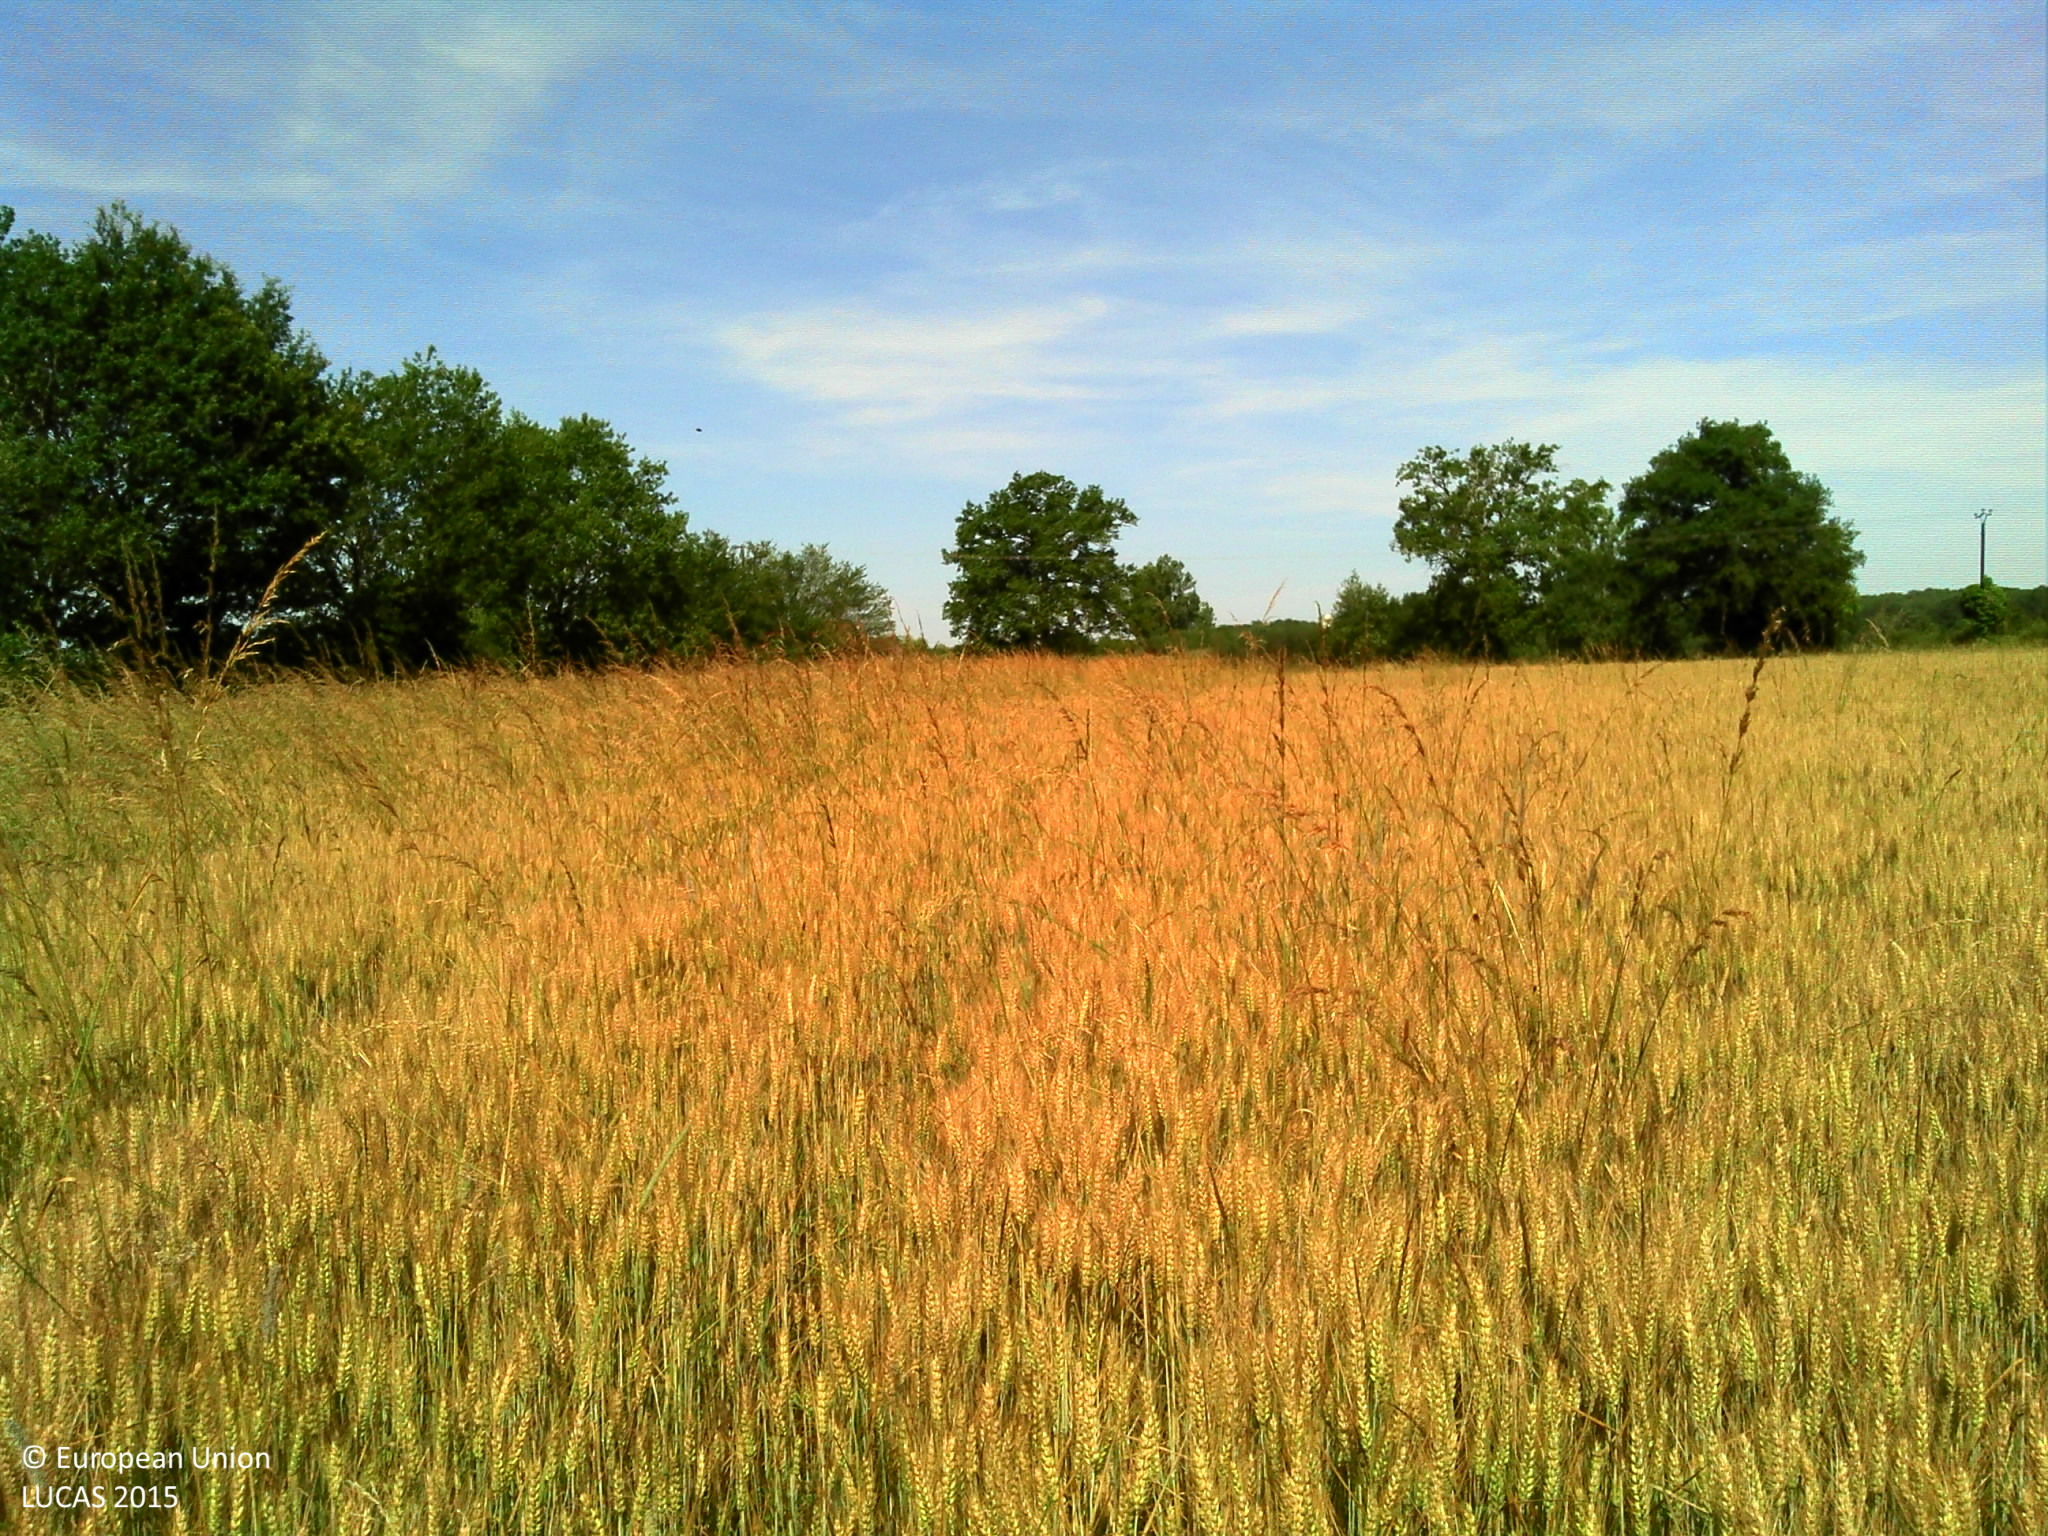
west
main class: Cropland
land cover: Common wheat
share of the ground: > 75 %
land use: Agriculture (excluding fallow land and kitchen gardens)
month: June
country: FR
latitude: 44.4954
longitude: 2.0149
